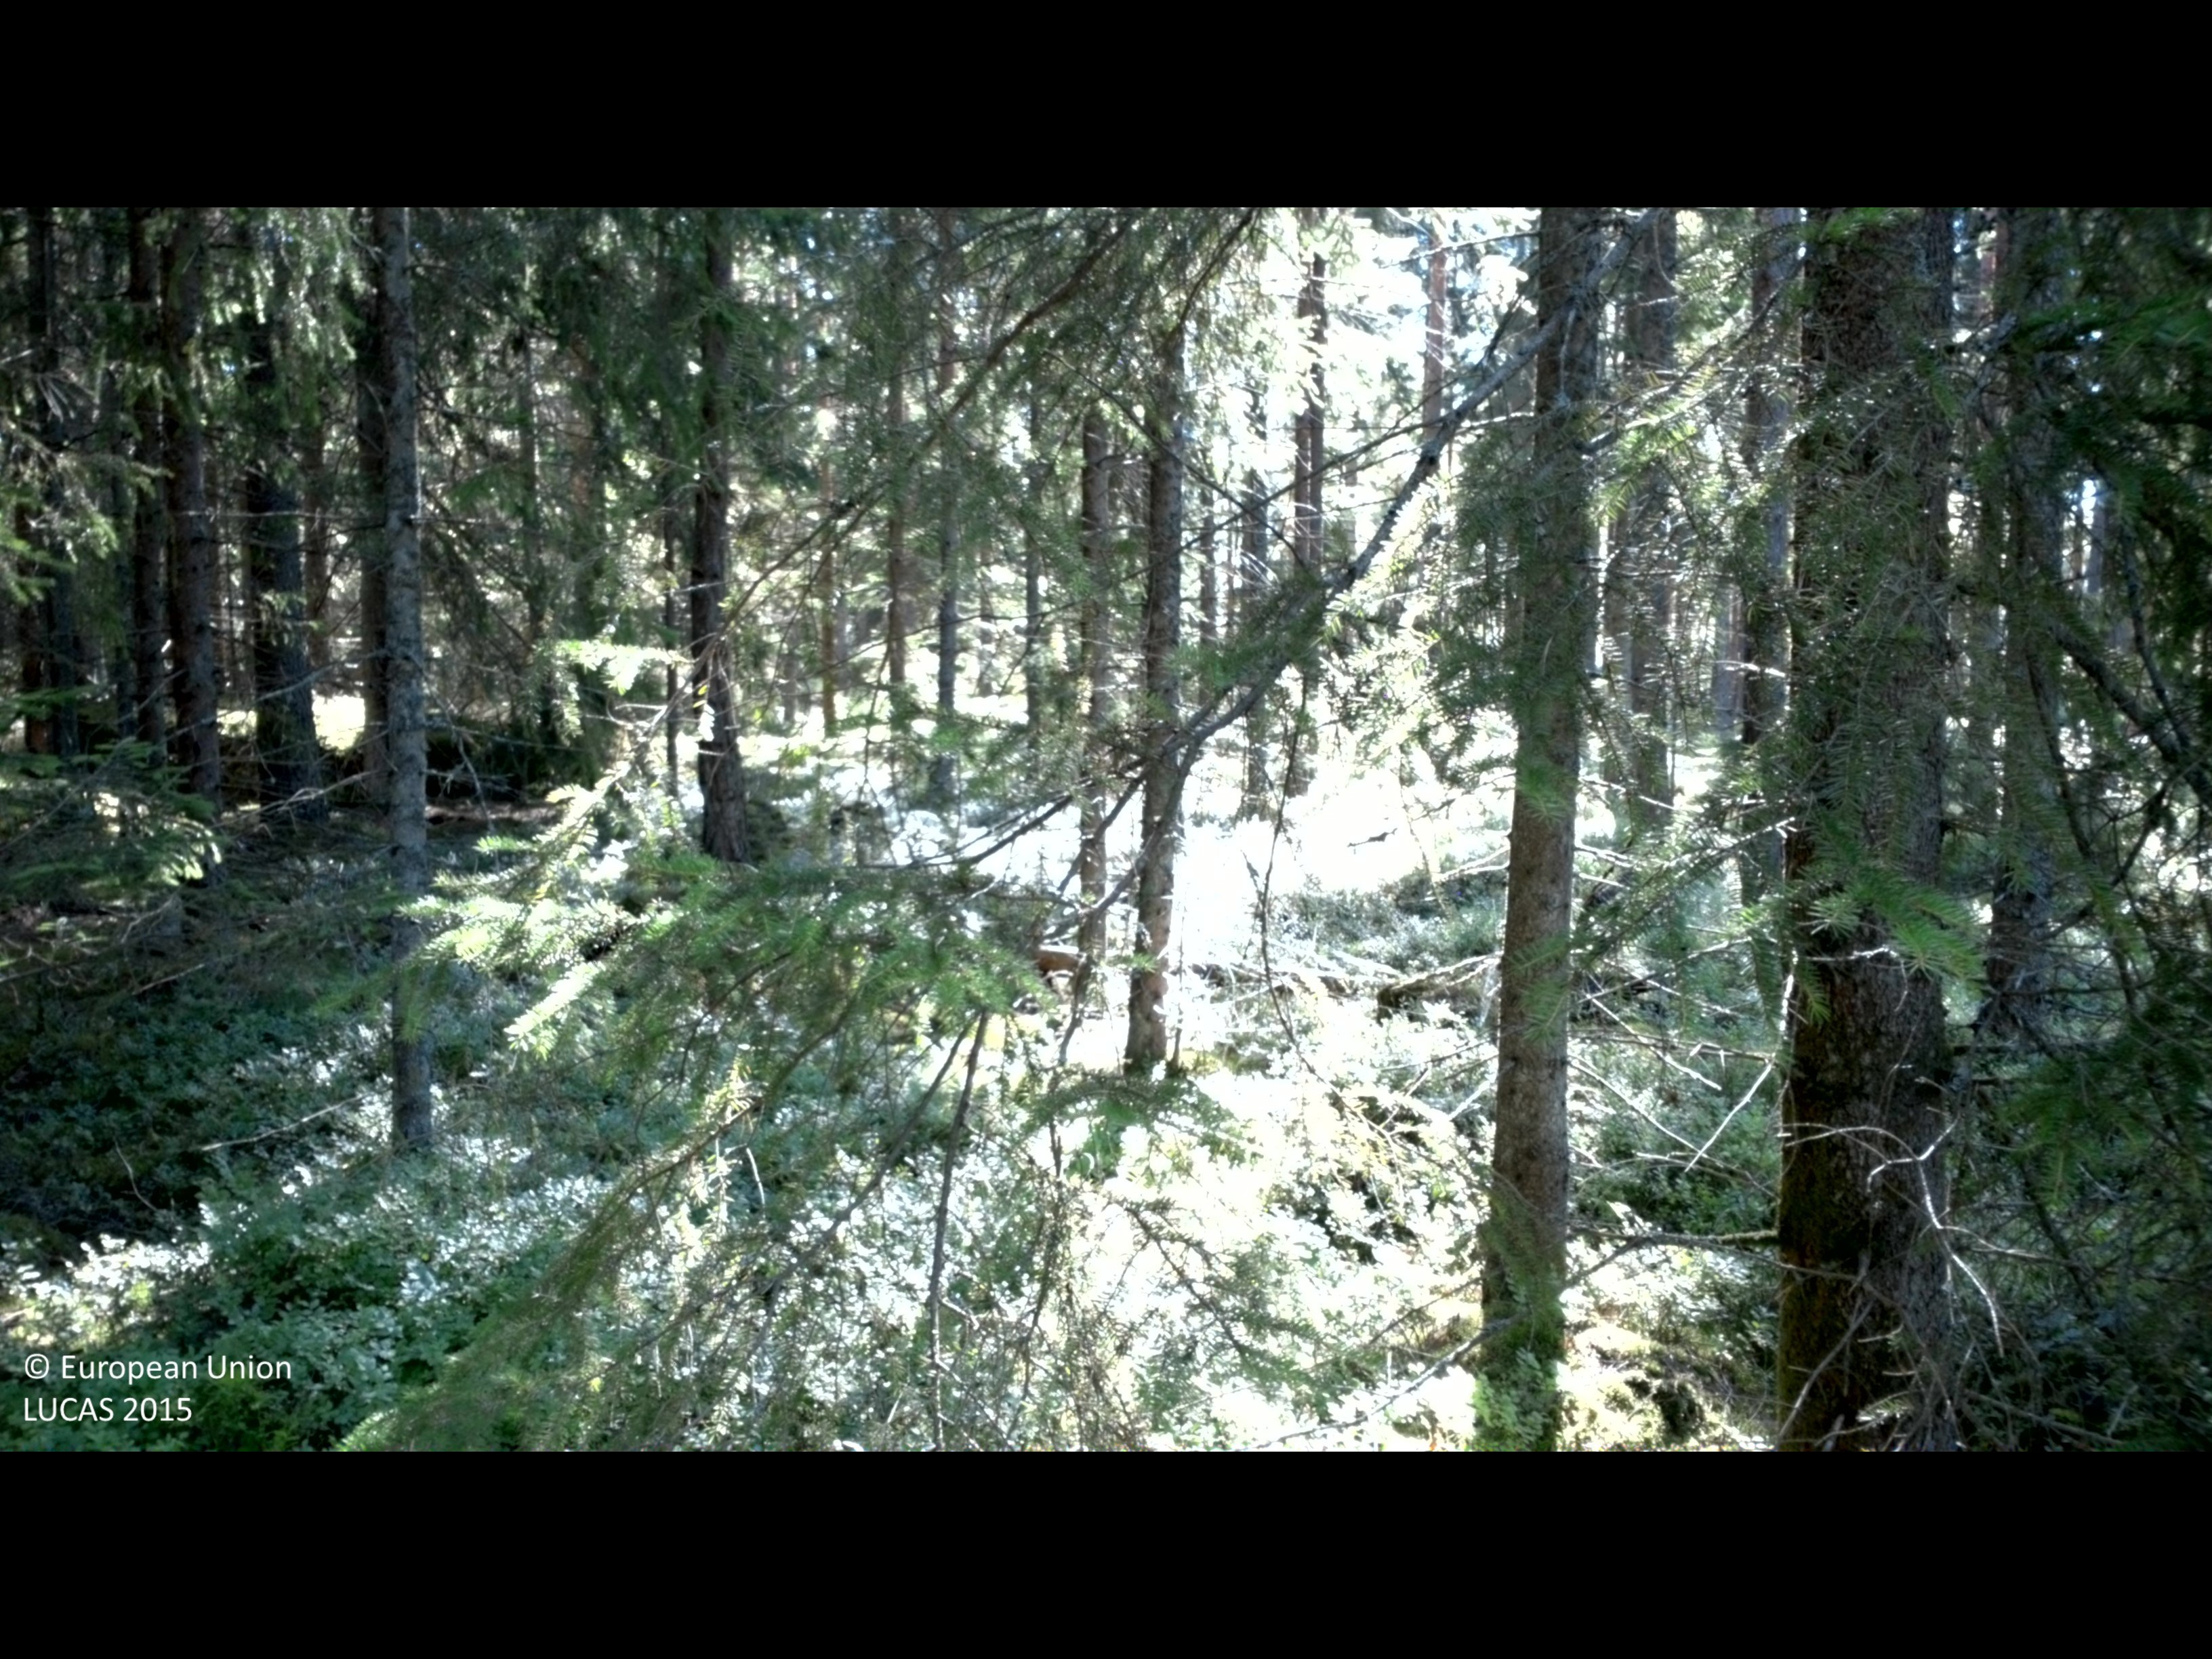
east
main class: Woodland
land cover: Pine dominated coniferous woodland
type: boreal forest
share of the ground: 50 - 75 %
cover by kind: coniferous forest trees 55 %, shrubs 45 %
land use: Forestry
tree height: > 5 m
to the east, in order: Pine dominated coniferous woodland; Spruce dominated coniferous woodland; Shrubland with sparse tree cover; Electric lines; Shrubland with sparse tree cover
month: August
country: SE
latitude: 56.3501
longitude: 14.8040
